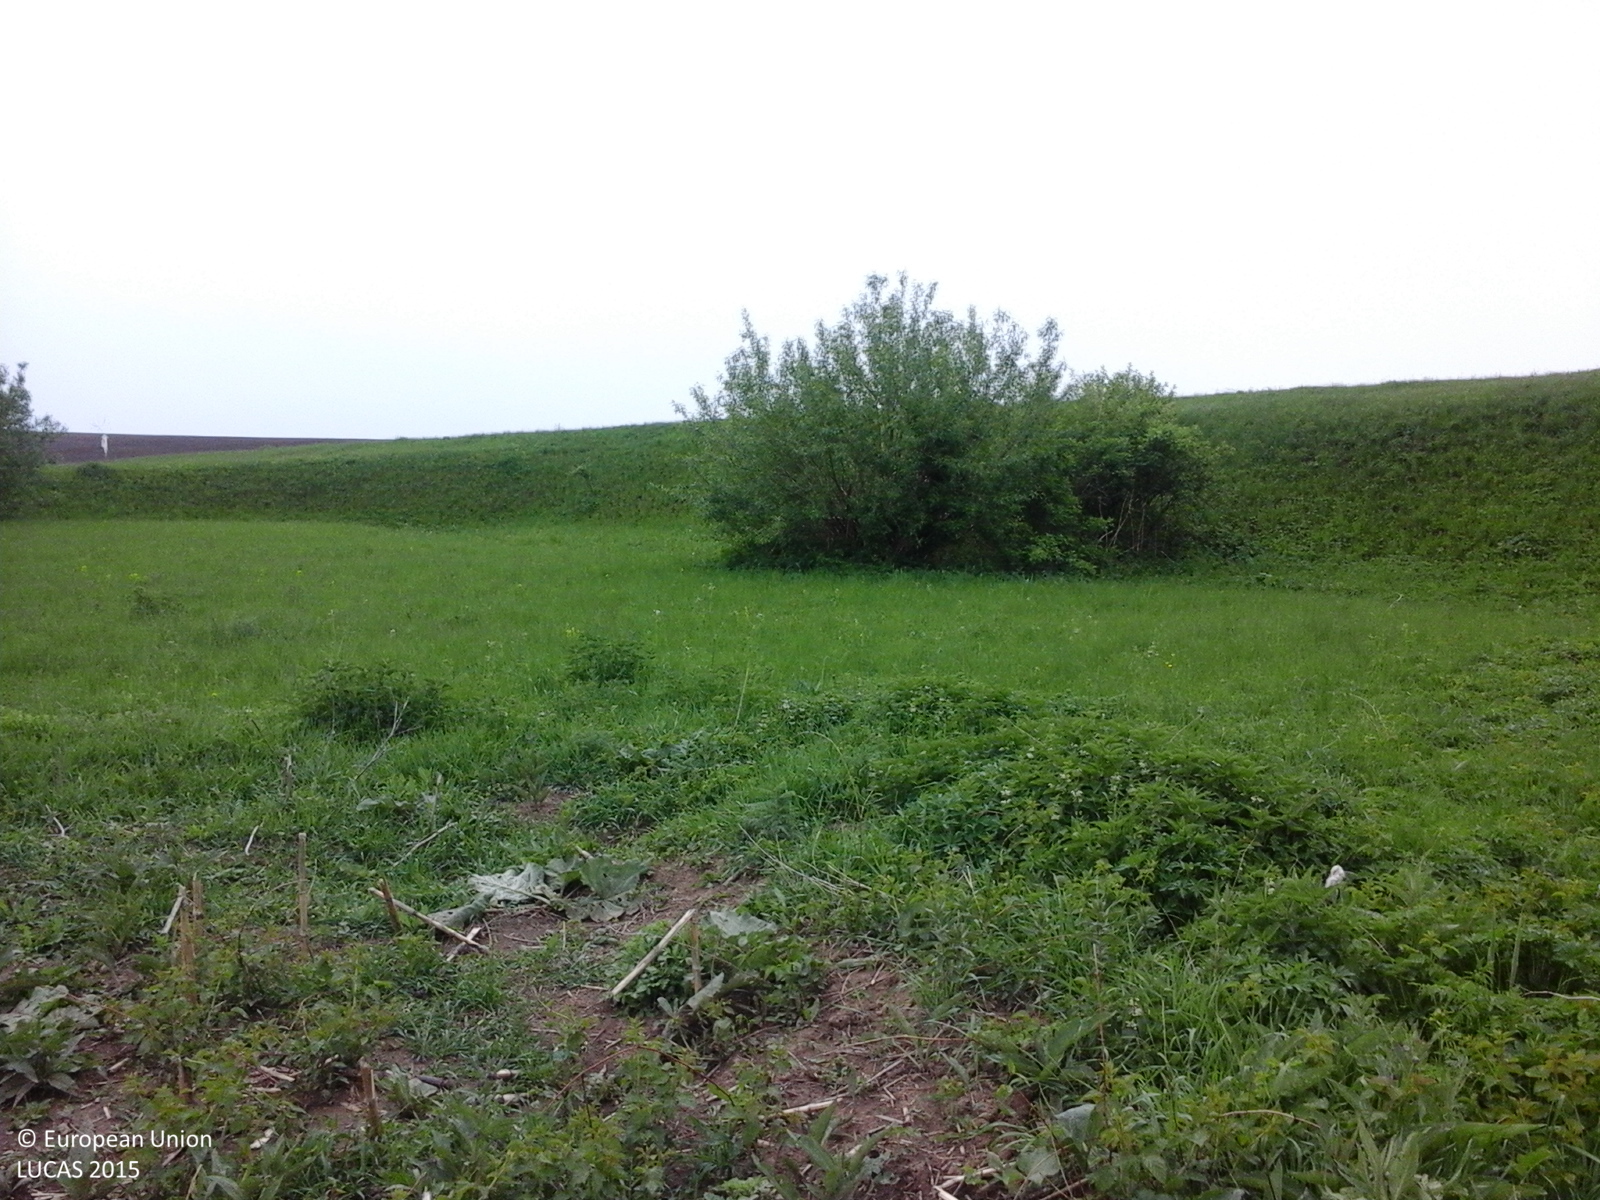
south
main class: Grassland
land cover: Spontaneously vegetated surfaces
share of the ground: 50 - 75 %
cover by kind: herbaceous plants 100 %
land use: Fallow land
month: May
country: RO
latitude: 45.8981
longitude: 26.0612
